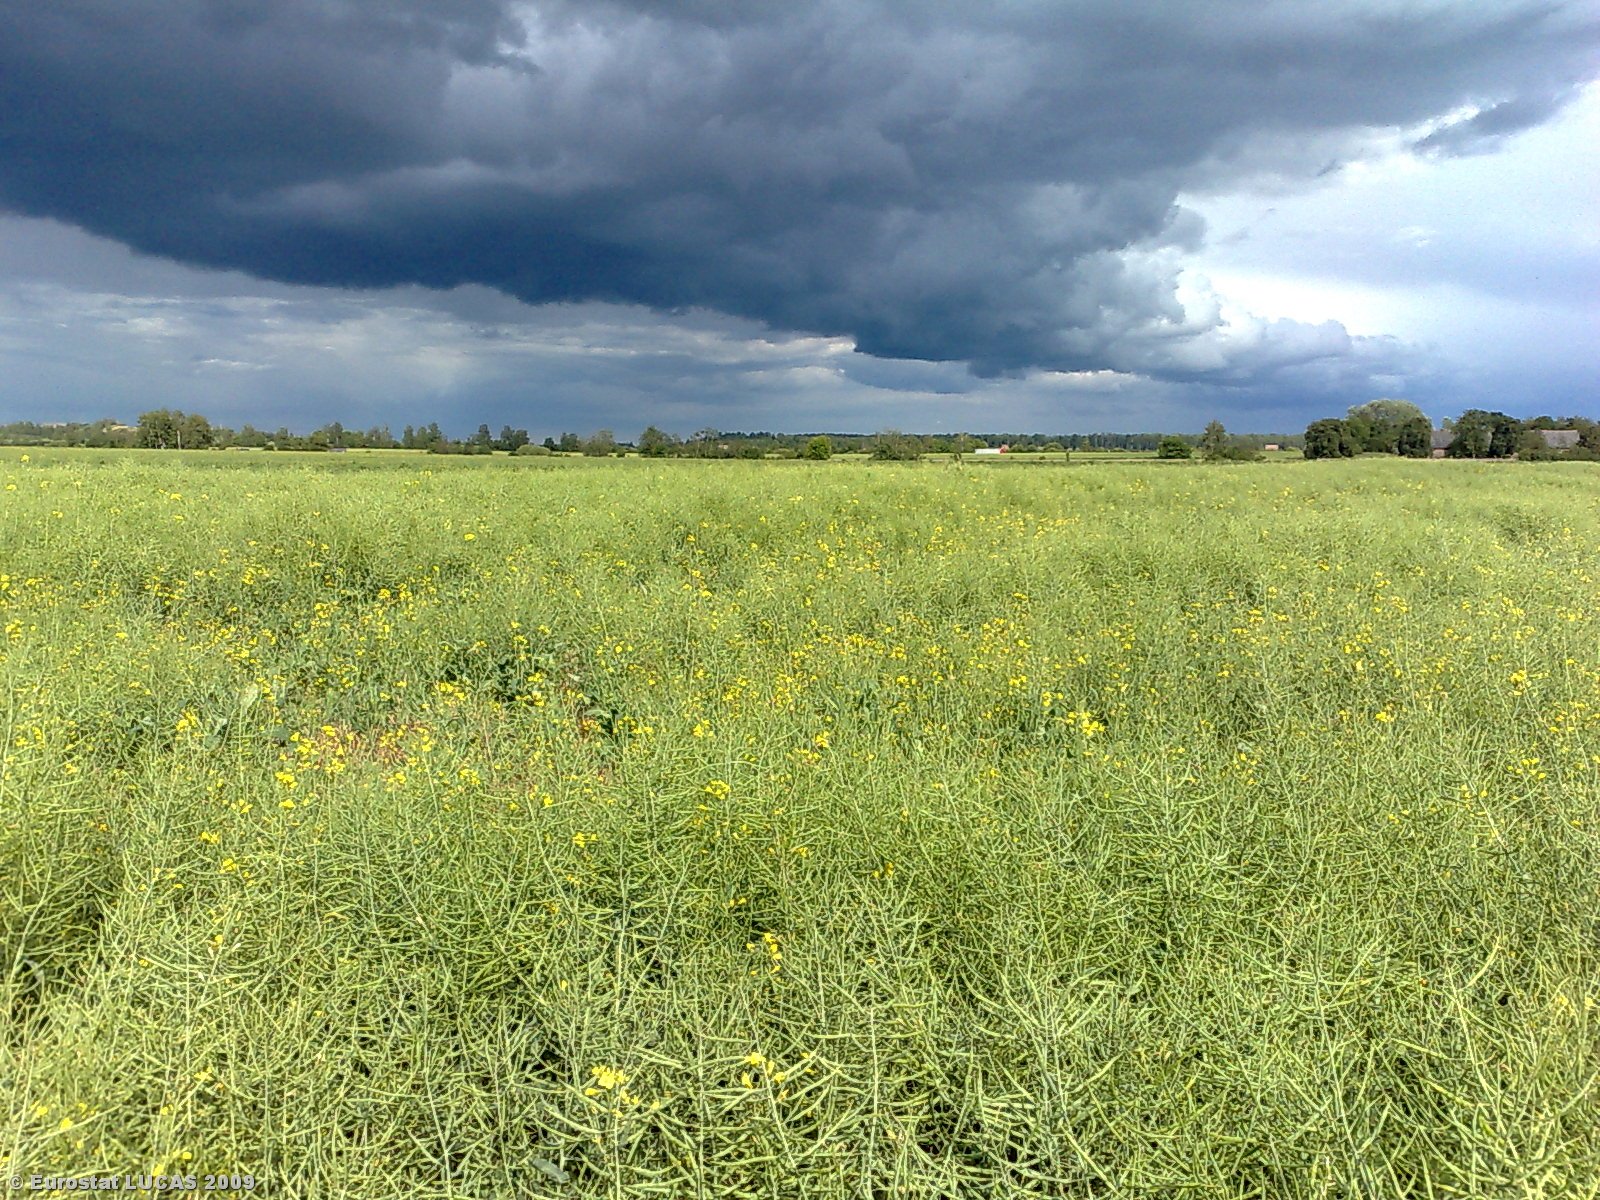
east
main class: Cropland
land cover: Rape and turnip rape
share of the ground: > 75 %
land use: Agriculture (excluding fallow land and kitchen gardens)
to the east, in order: Rape and turnip rape; Other root crops
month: June
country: LT
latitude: 56.0116
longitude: 23.8951
